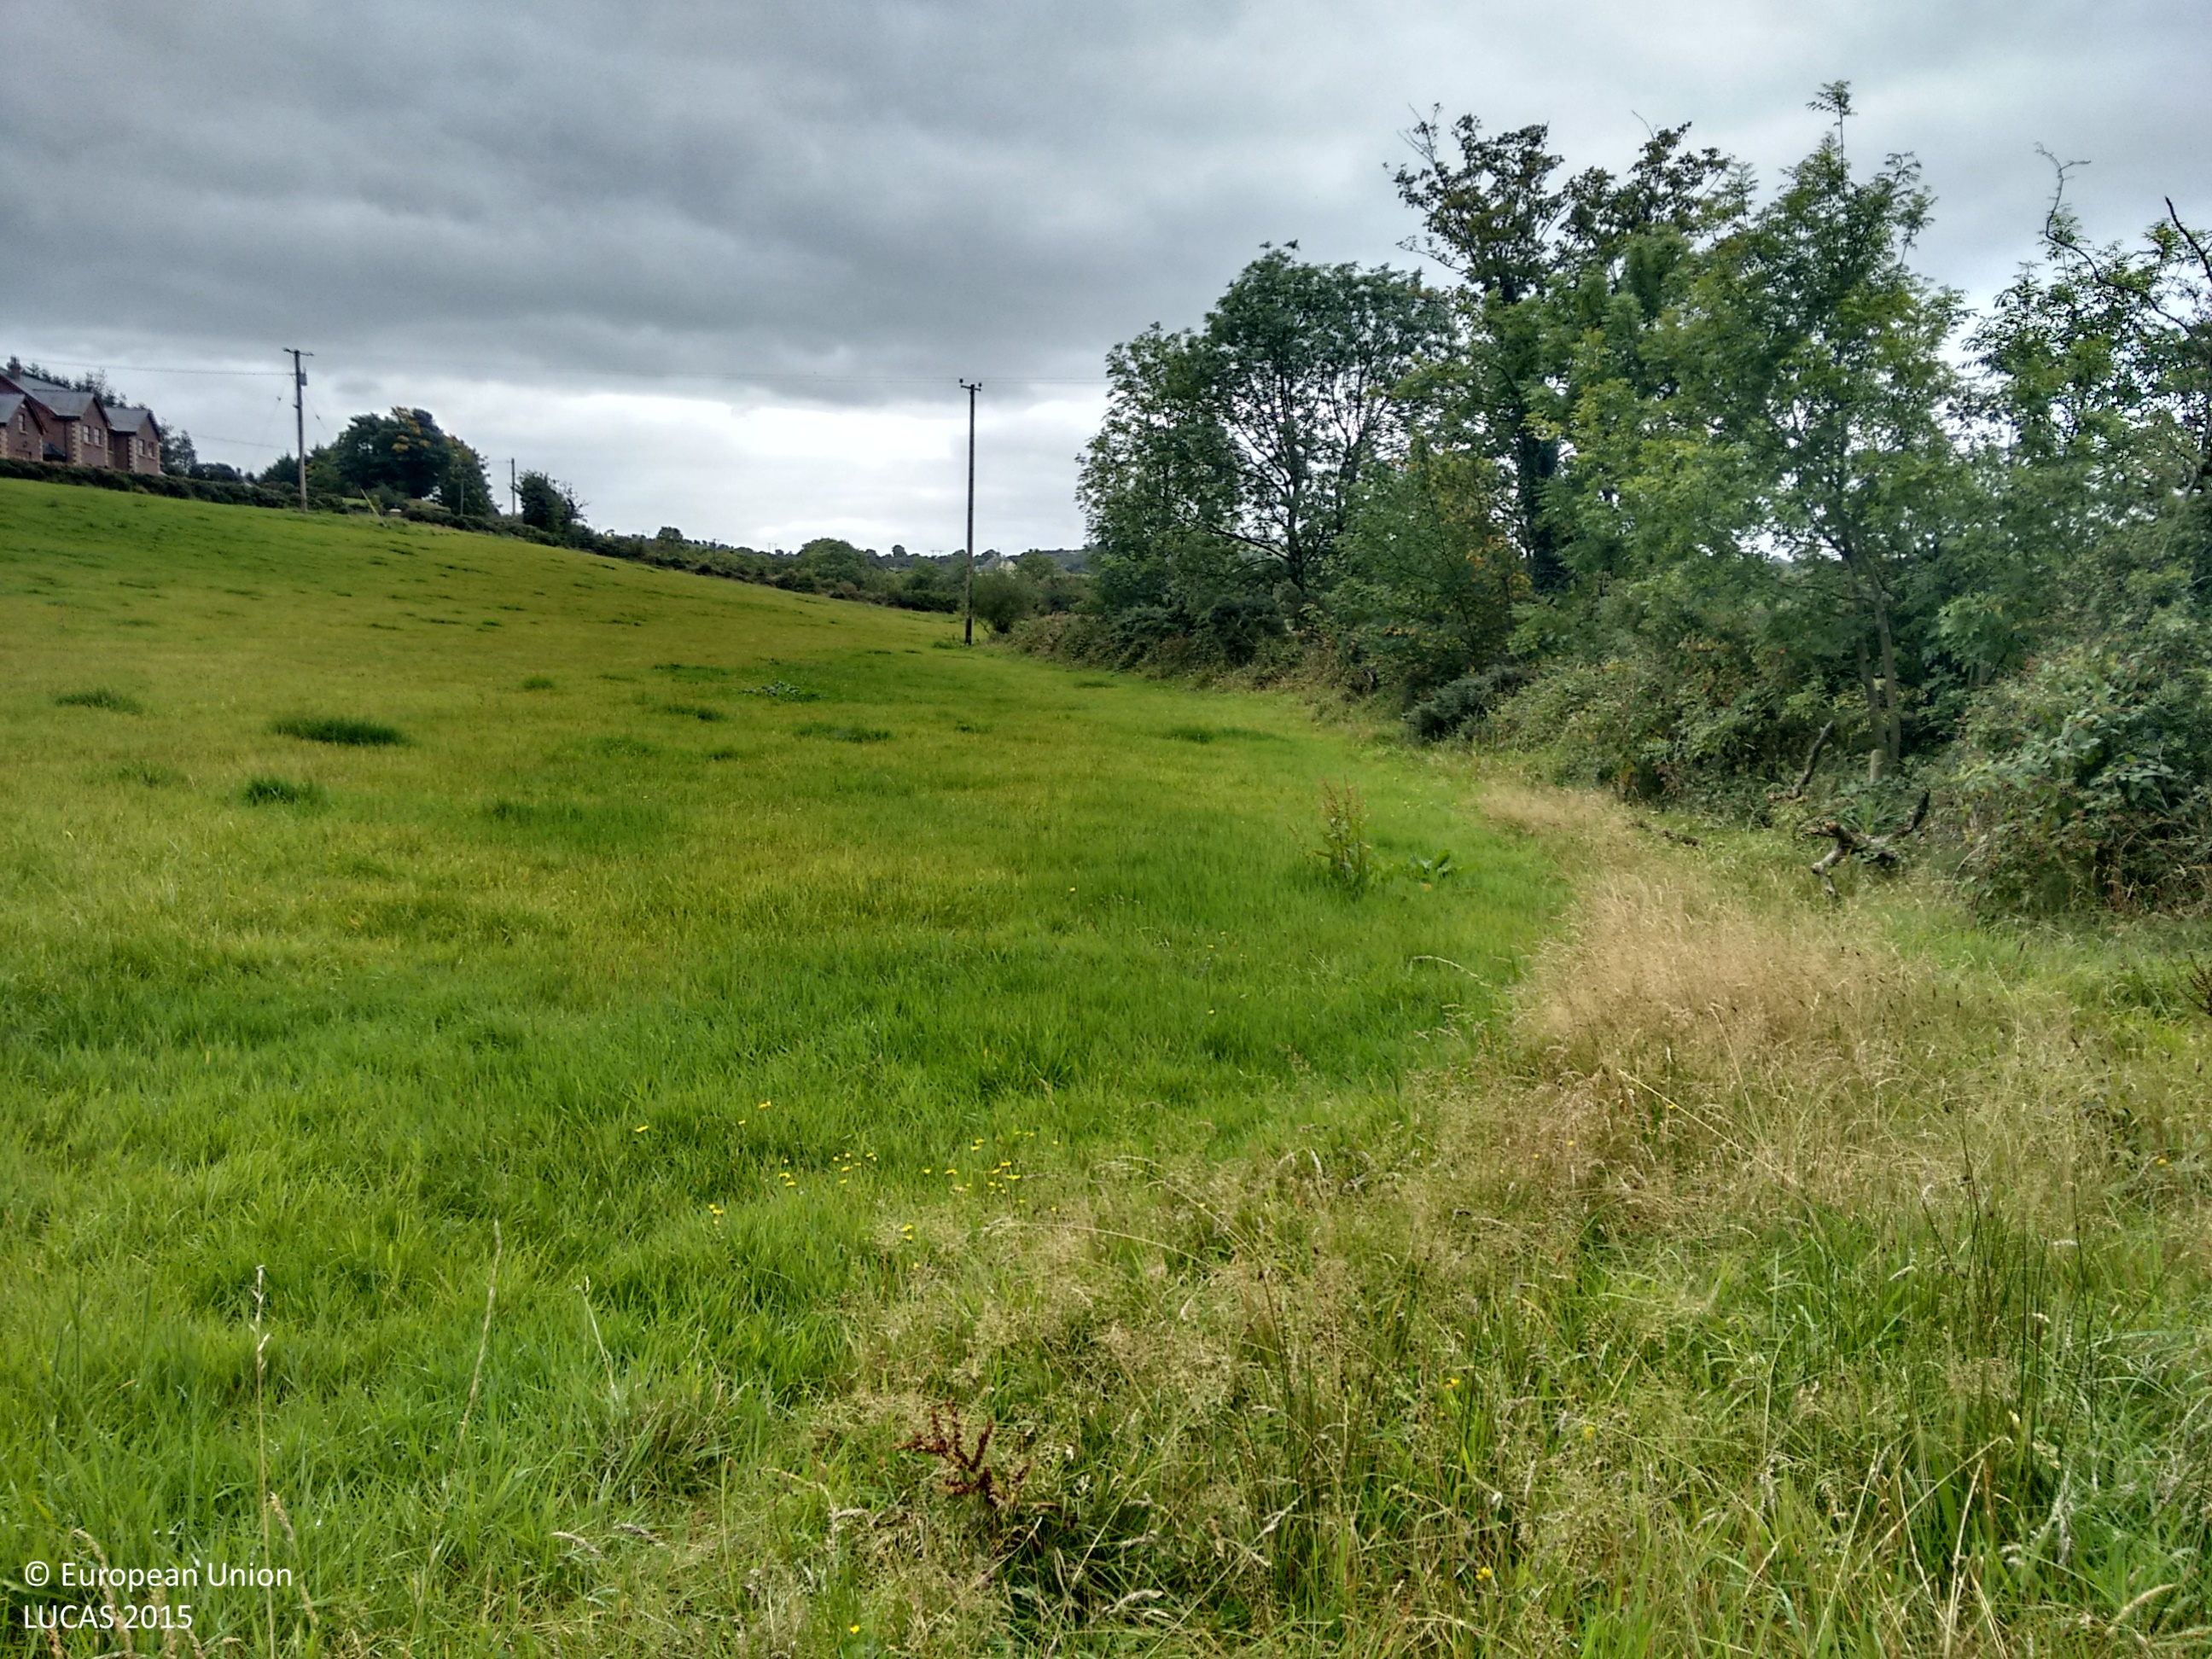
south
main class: Grassland
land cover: Grassland without tree/shrub cover
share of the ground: > 75 %
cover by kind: herbaceous plants 100 %
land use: Agriculture (excluding fallow land and kitchen gardens)
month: September
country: IE
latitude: 54.1290
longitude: -6.7993
